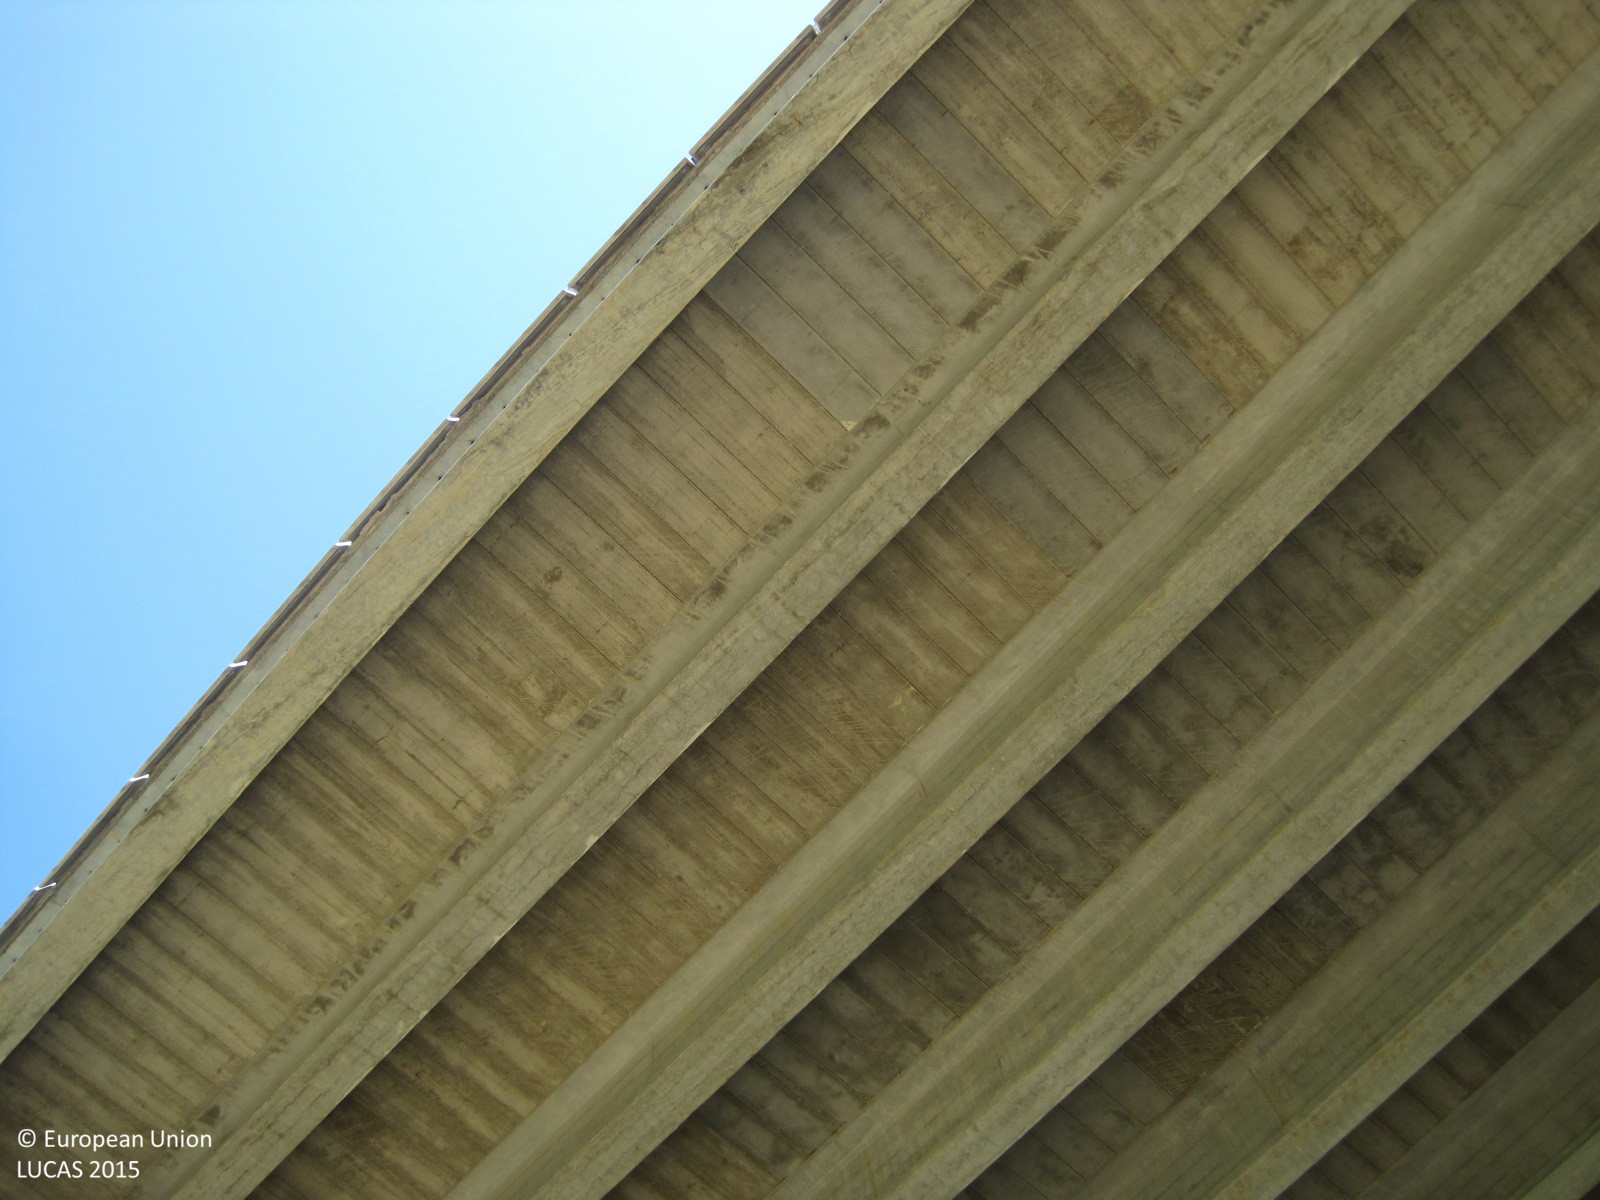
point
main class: Artificial land
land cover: Non built-up linear features
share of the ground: > 75 %
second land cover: Grassland without tree/shrub cover
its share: > 75 %
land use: Road transport
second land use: Forestry
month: May
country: ES
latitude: 39.4305
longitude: -0.8148
